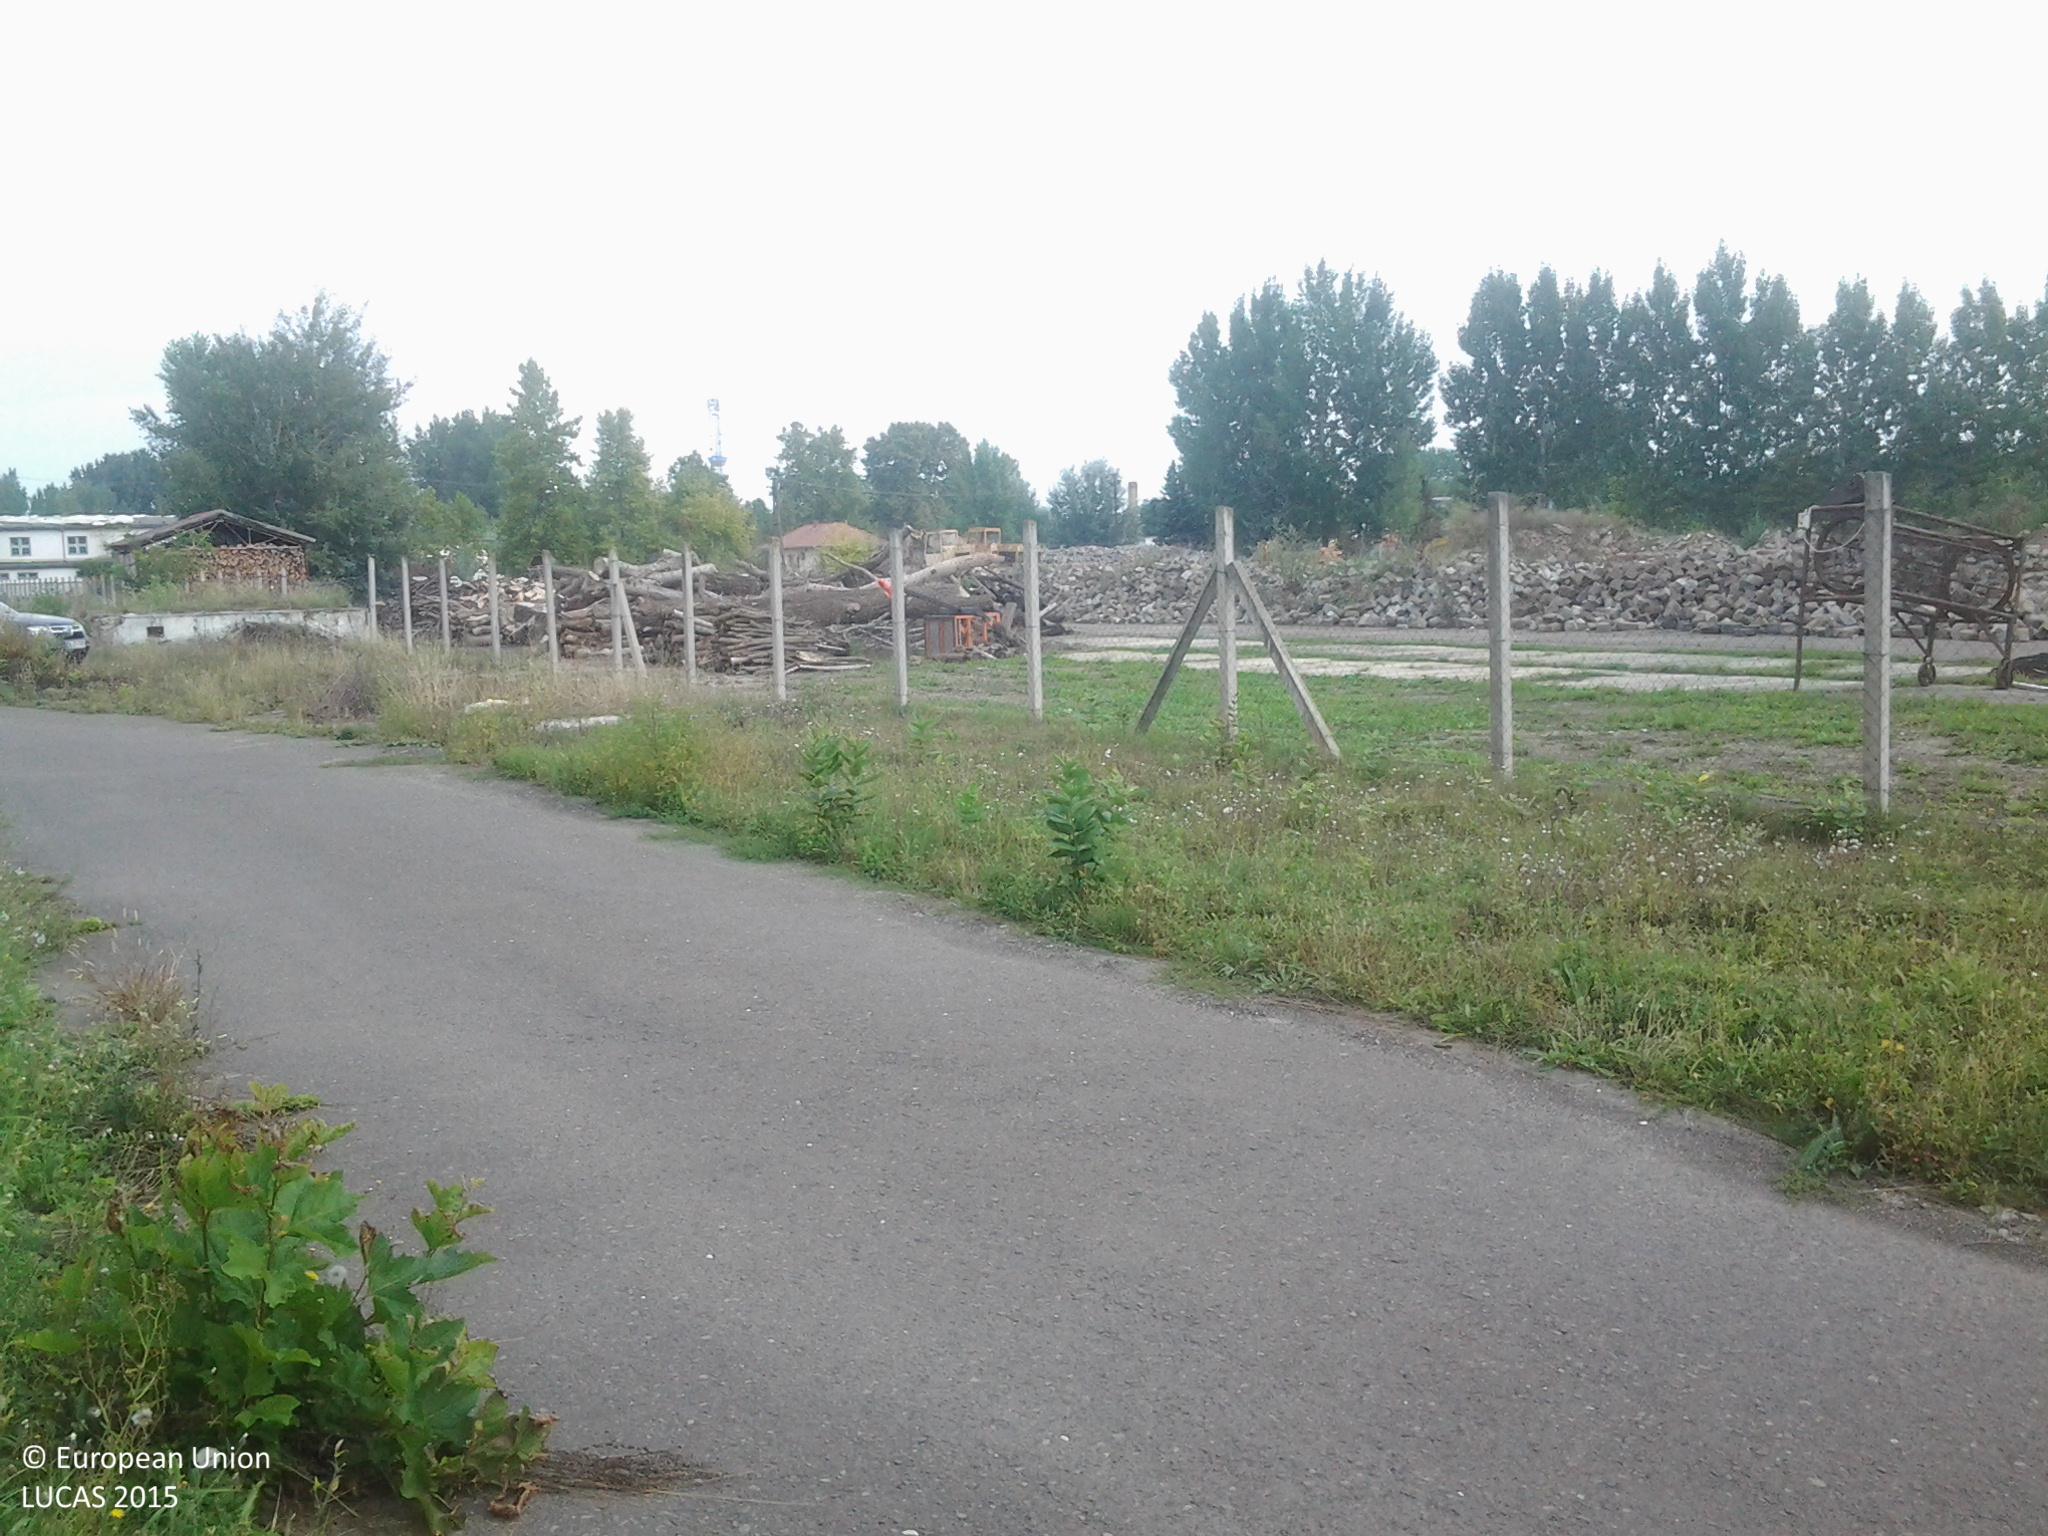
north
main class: Grassland
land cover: Spontaneously vegetated surfaces
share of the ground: > 75 %
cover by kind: herbaceous plants 100 %
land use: Residential
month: August
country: HU
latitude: 46.1558
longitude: 18.9596
